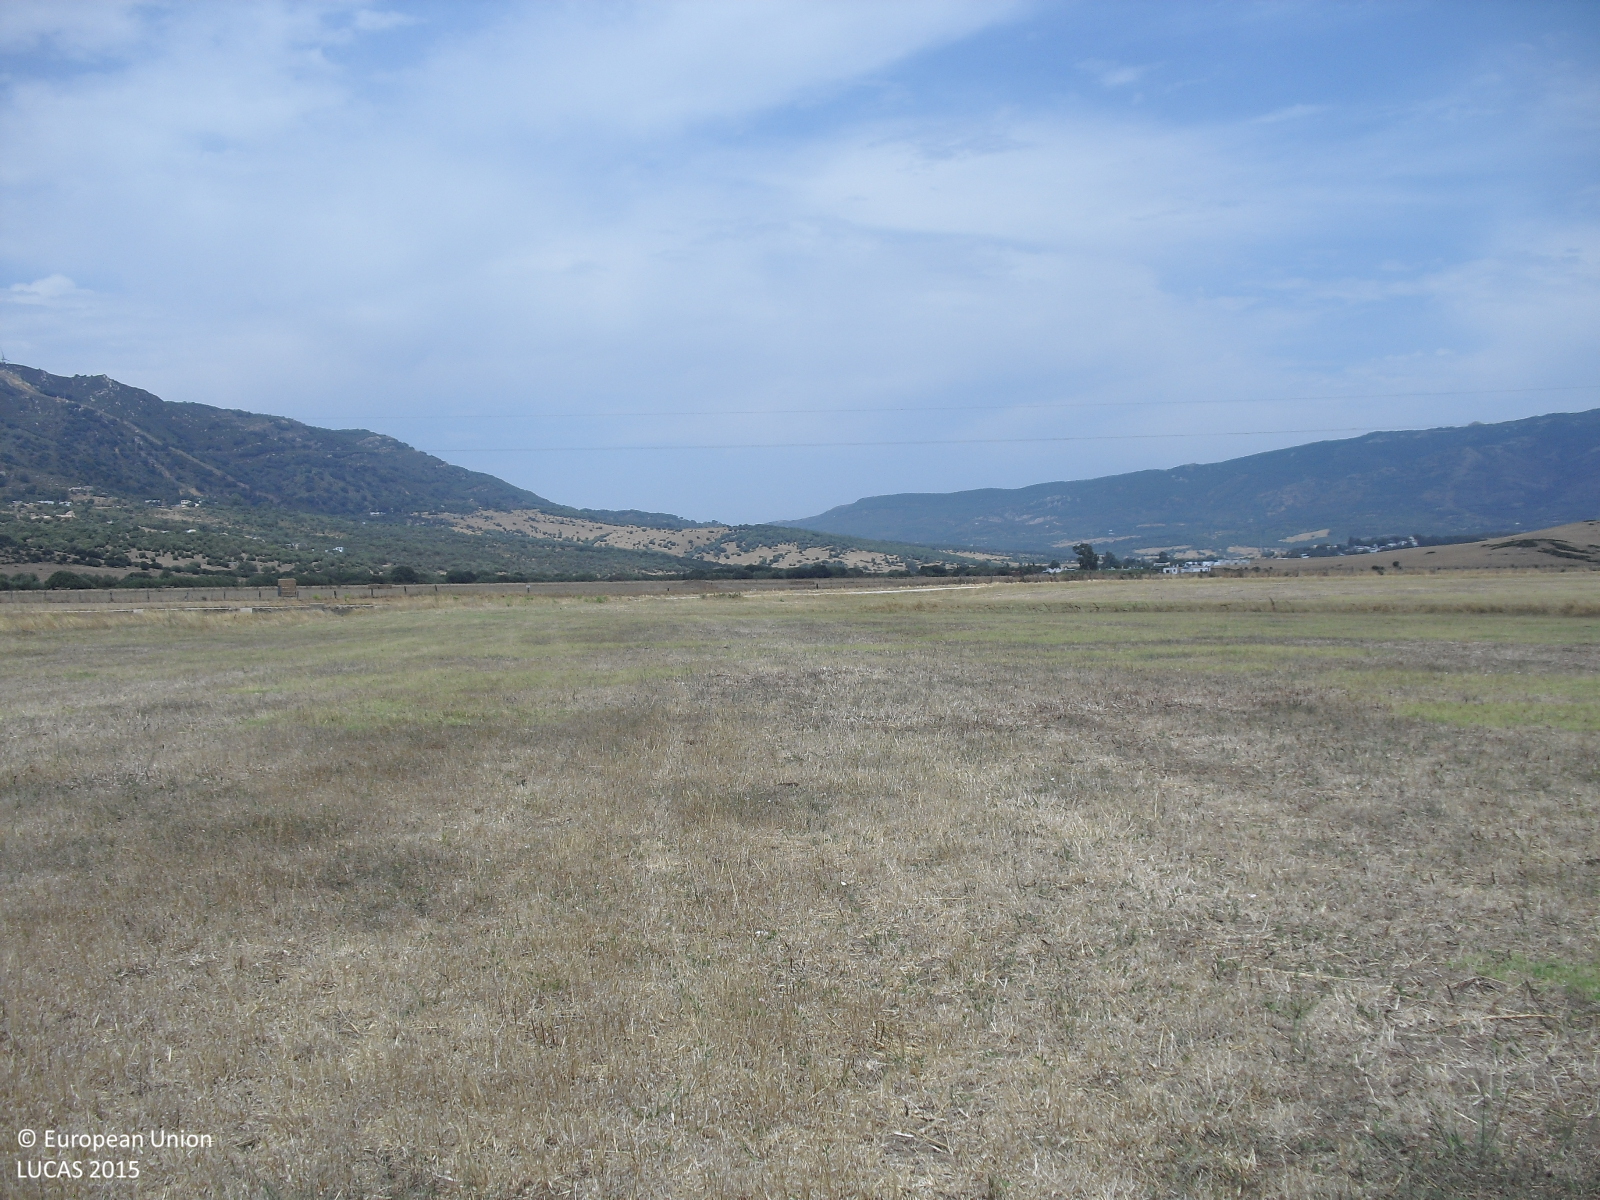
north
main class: Grassland
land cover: Spontaneously vegetated surfaces
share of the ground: 25 - 50 %
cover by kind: unconsolidated bare surface 65 %, herbaceous plants 35 %
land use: Agriculture (excluding fallow land and kitchen gardens)
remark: Harvested field
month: July
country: ES
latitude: 36.0585
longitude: -5.6344
